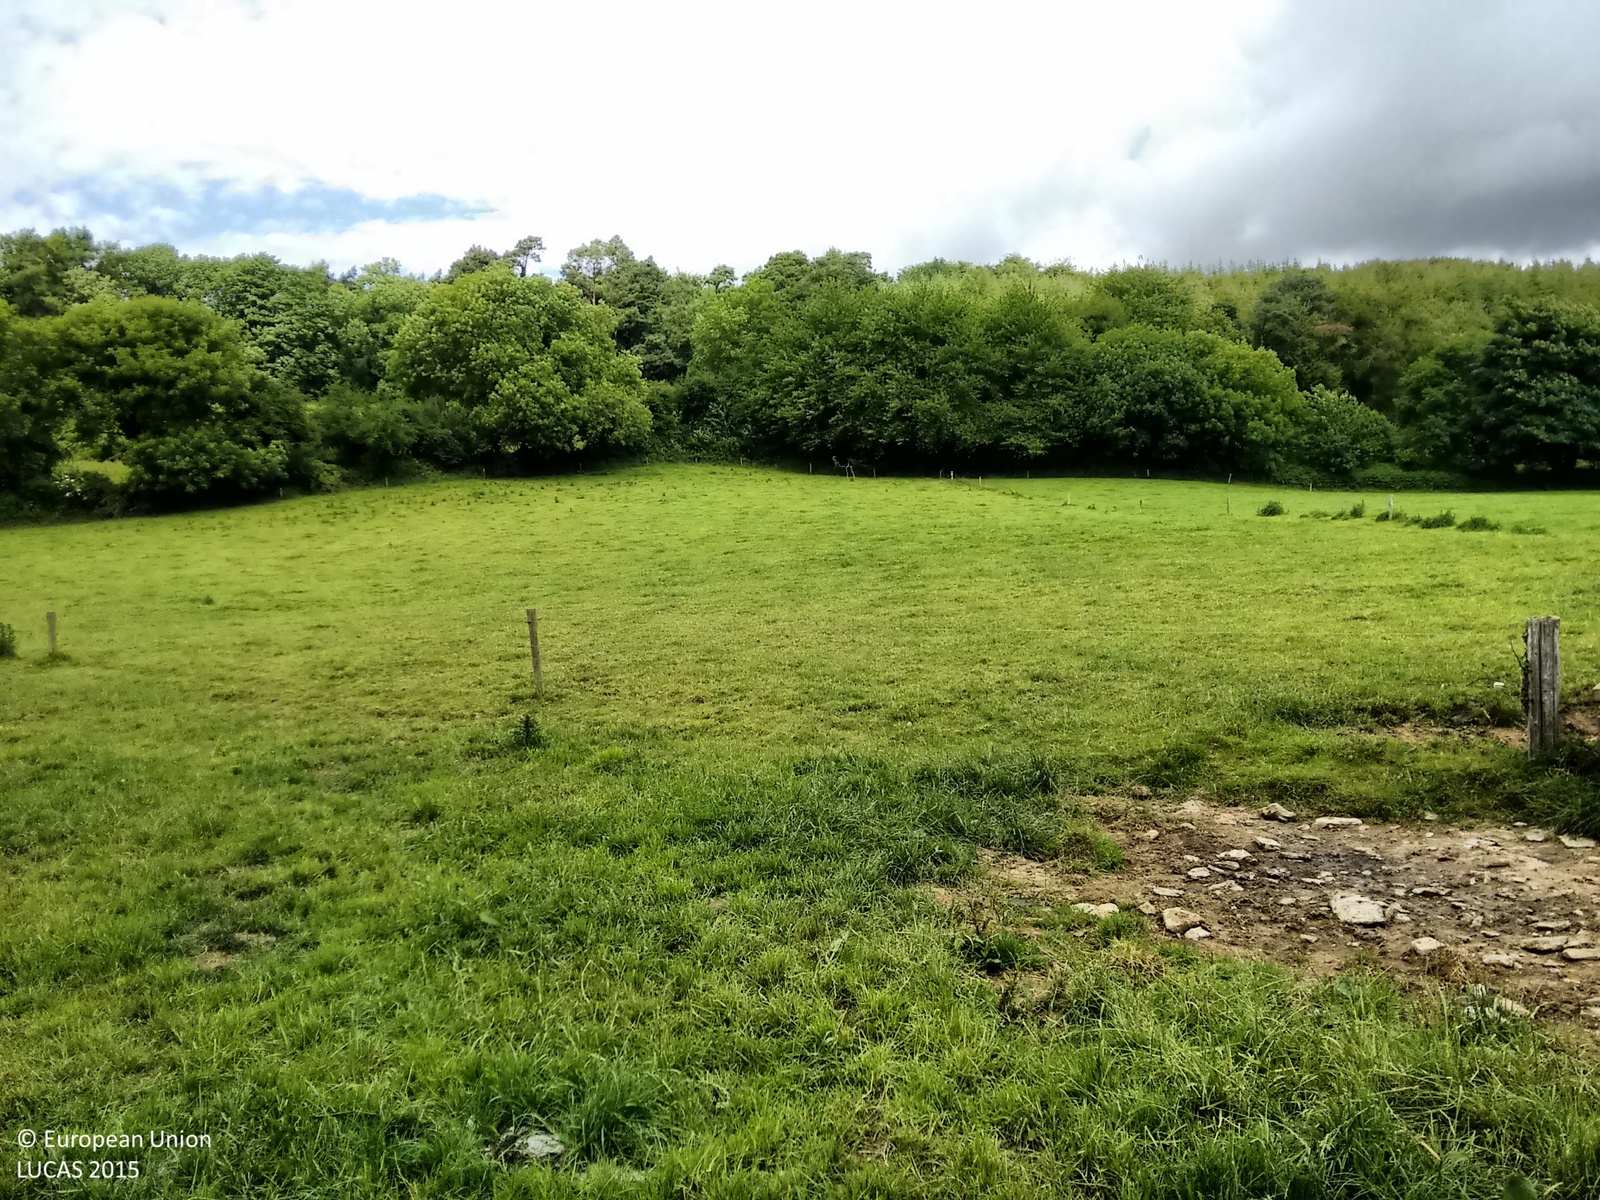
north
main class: Grassland
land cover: Grassland without tree/shrub cover
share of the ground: > 75 %
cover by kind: herbaceous plants 95 %, unconsolidated bare surface 5 %
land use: Agriculture (excluding fallow land and kitchen gardens)
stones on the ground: < 10 %
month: June
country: IE
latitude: 52.4000
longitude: -7.4261
